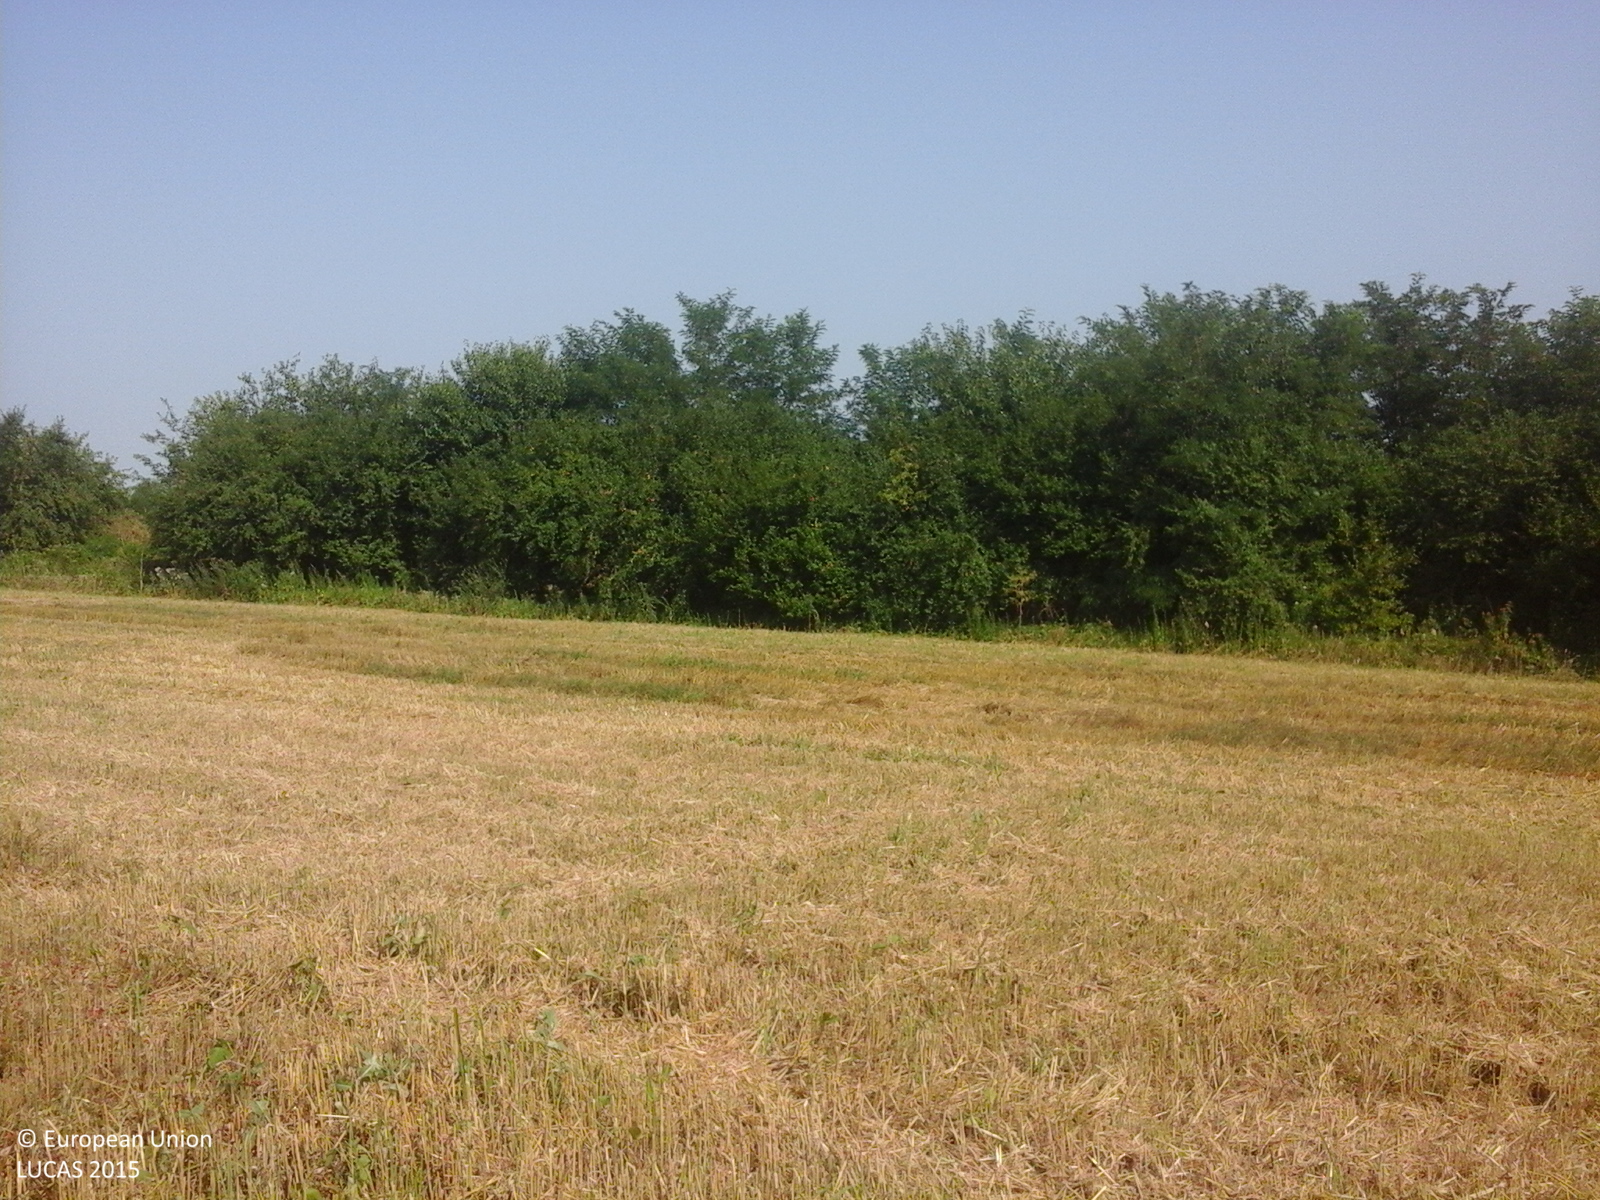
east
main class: Cropland
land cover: Common wheat
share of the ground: 50 - 75 %
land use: Agriculture (excluding fallow land and kitchen gardens)
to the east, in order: Common wheat; Broadleaved woodland; Lucerne; Spontaneously vegetated surfaces; Vineyards; Spontaneously vegetated surfaces; Tracks; Spontaneously vegetated surfaces; Electric lines; Grass margins; Tracks
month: July
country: RO
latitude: 44.5709
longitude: 26.4472
